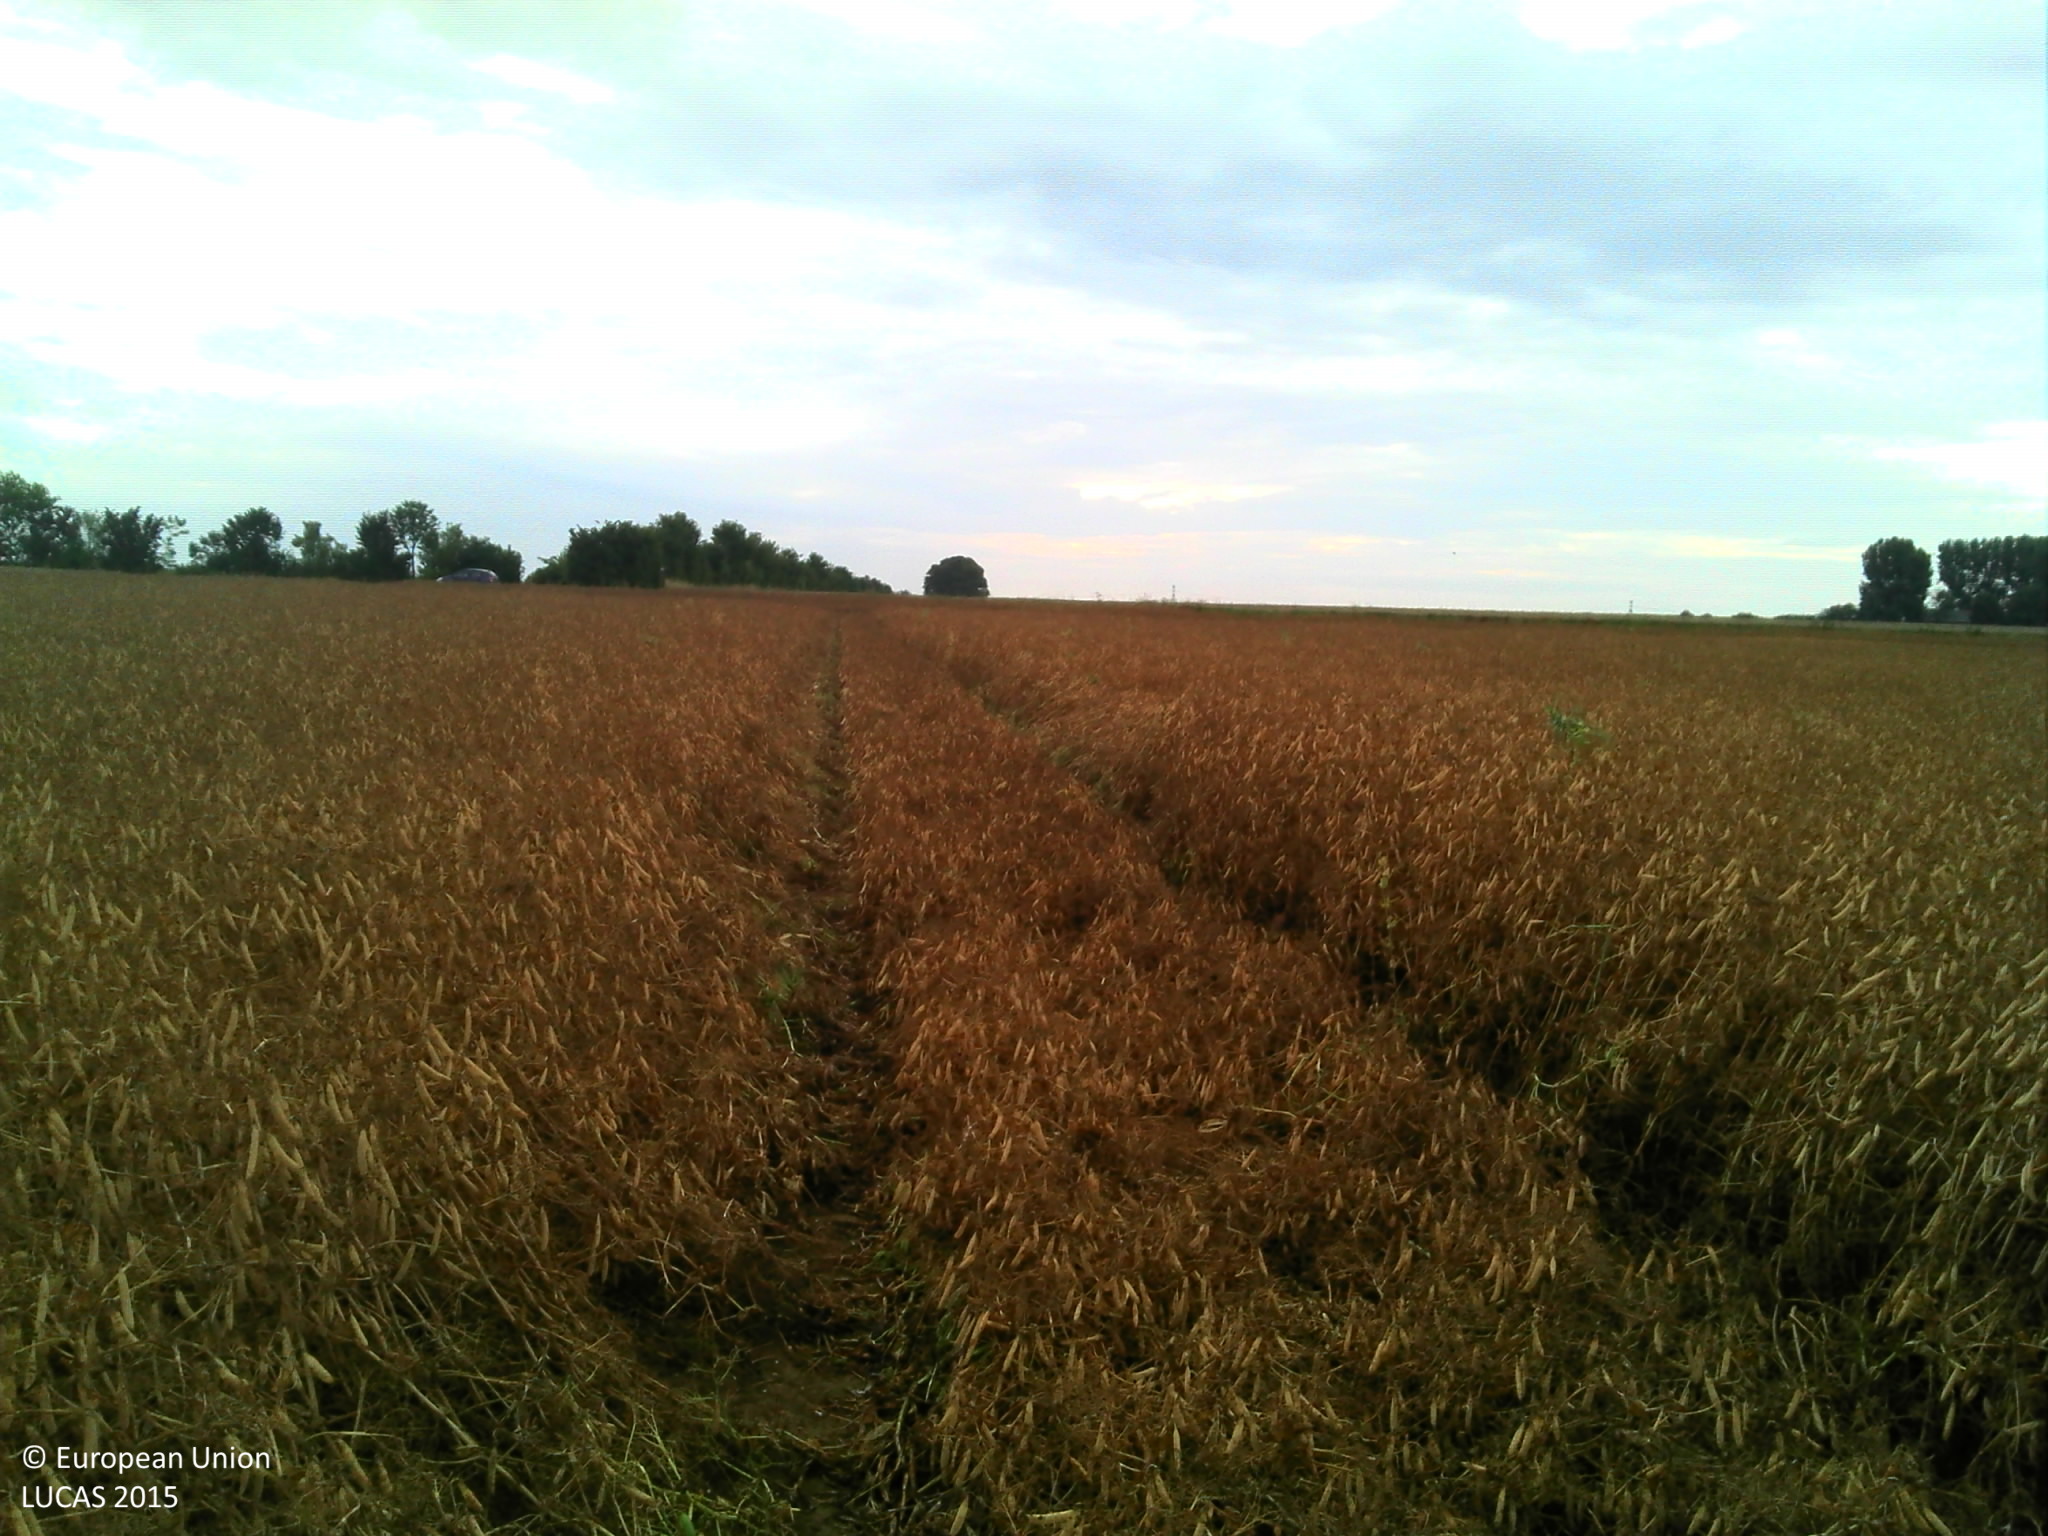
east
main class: Cropland
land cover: Dry pulses
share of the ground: > 75 %
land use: Agriculture (excluding fallow land and kitchen gardens)
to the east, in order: Dry pulses; Grass margins; Paved roads, cycling and walking lanes; Grass margins; Common wheat
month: July
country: FR
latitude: 50.0241
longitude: 2.1831
